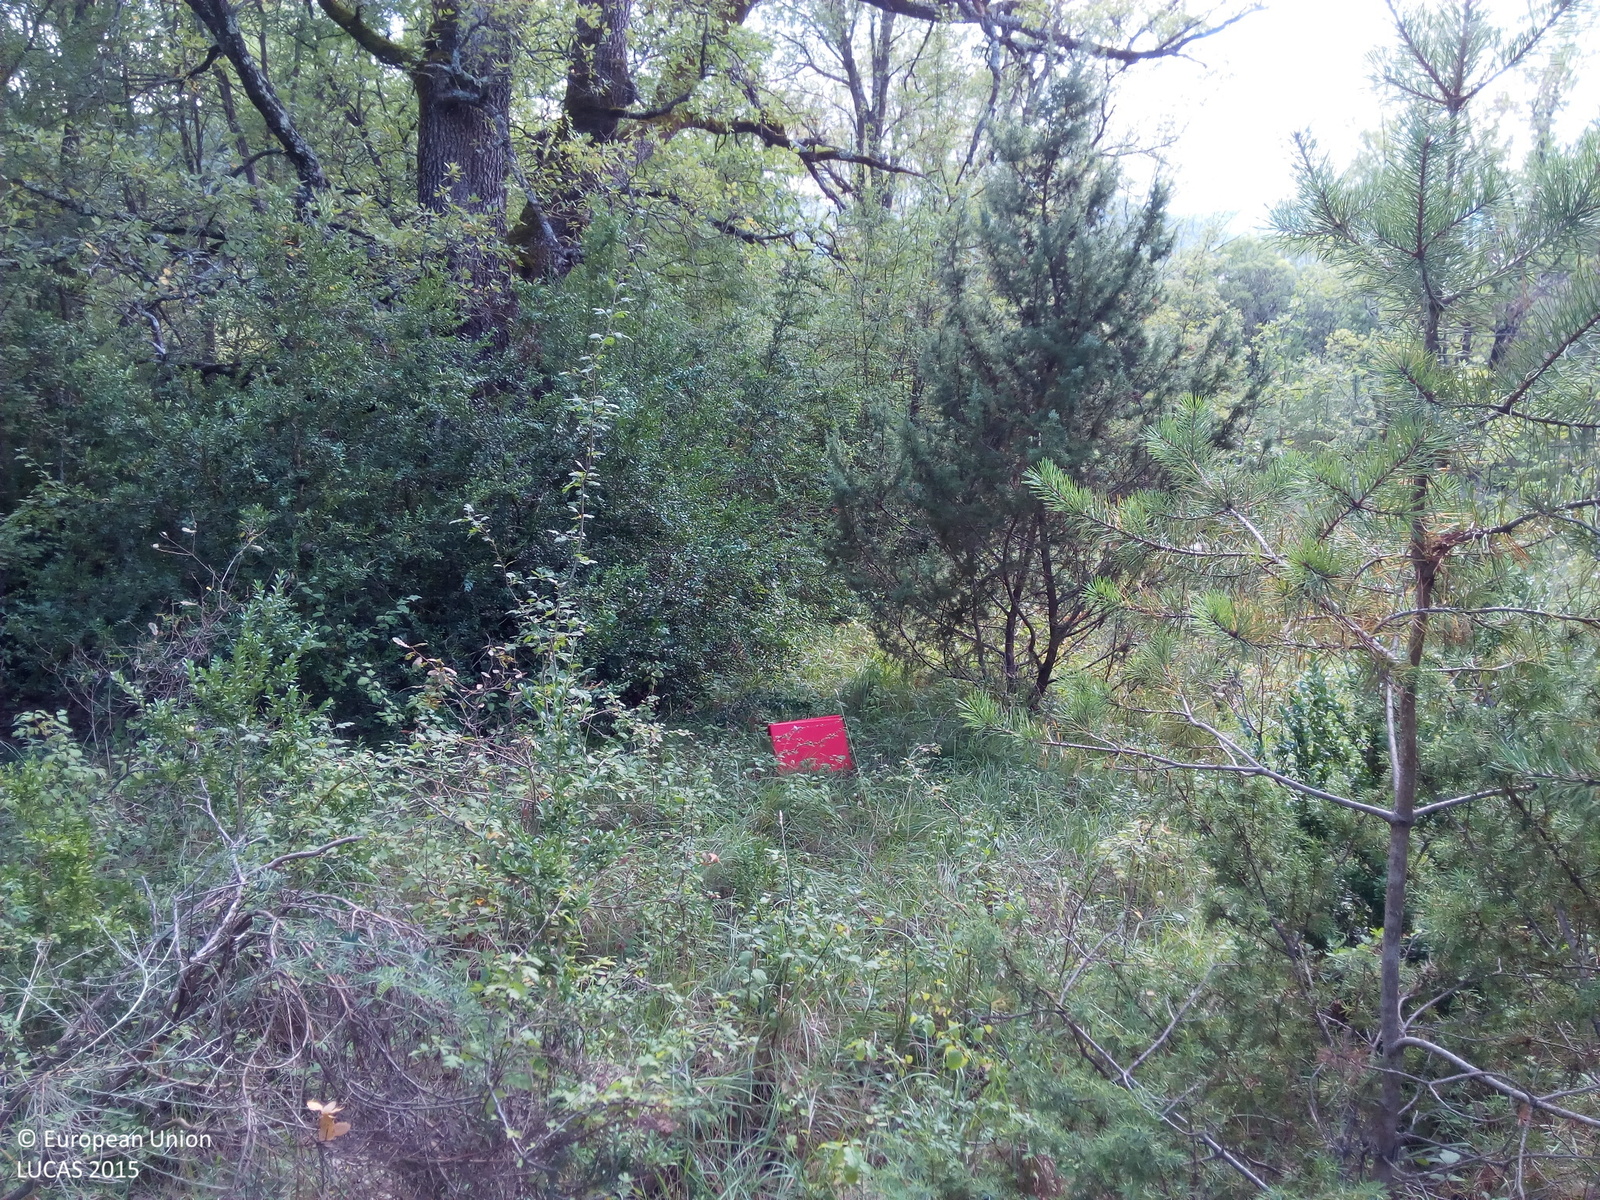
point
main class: Woodland
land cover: Broadleaved woodland
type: broadleaved evergreen forest
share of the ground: > 75 %
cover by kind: broadleaved forest trees 100 %
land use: Semi-natural and natural areas not in use
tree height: > 5 m
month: September
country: ES
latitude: 42.4639
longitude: -0.0316
